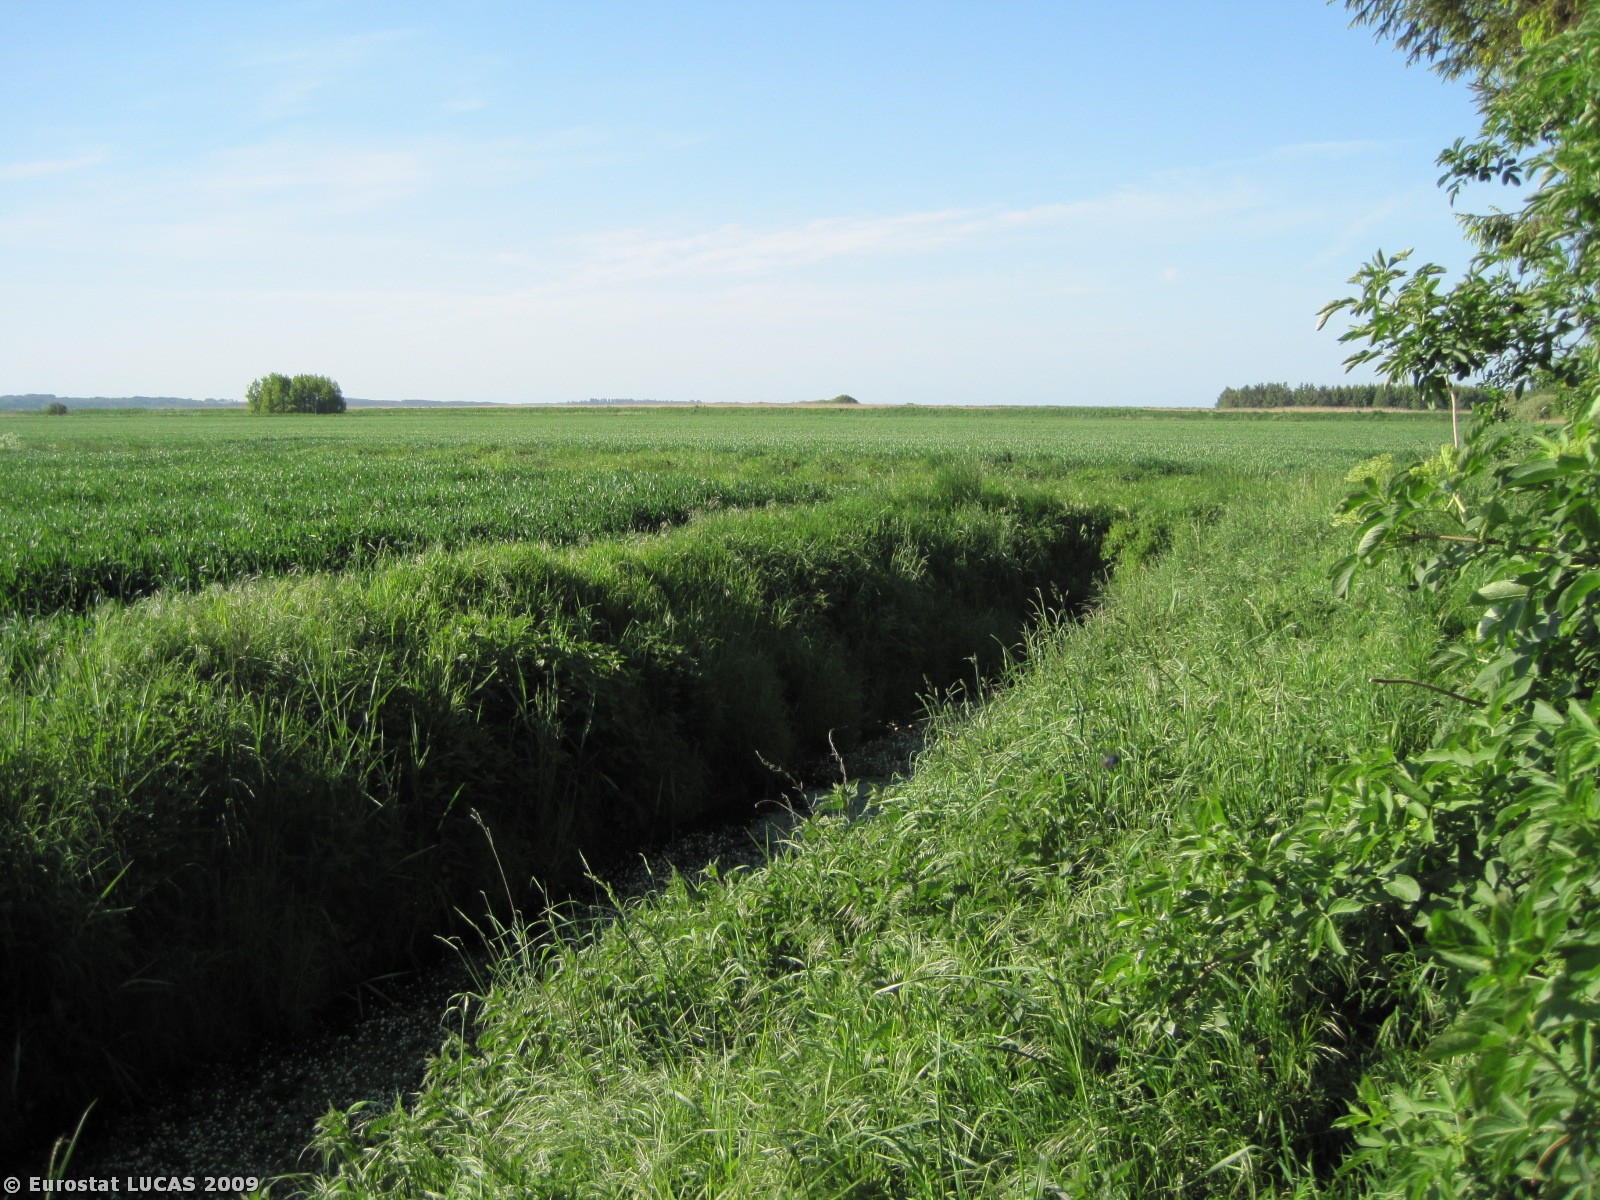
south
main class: Woodland
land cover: Mixed woodland
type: plantations and self-sown exotic forest
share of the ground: > 75 %
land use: Unused
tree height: > 5 m
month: May
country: DK
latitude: 56.5830
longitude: 10.2439
